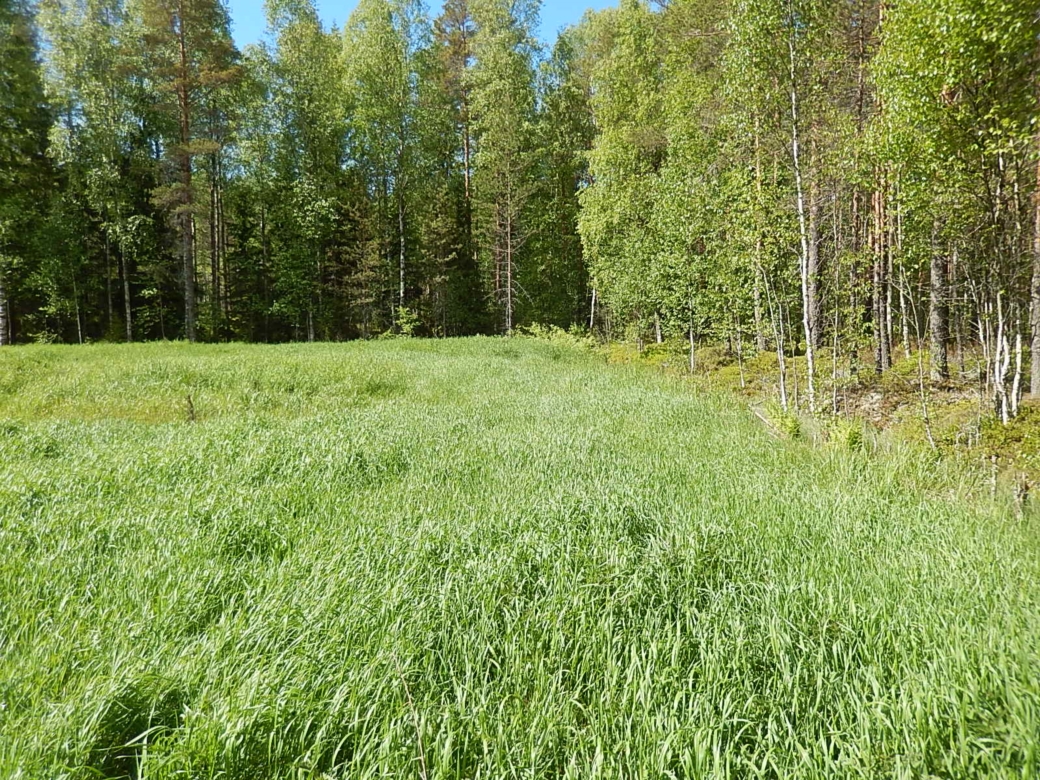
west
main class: Grassland
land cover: Grassland without tree/shrub cover
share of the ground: > 75 %
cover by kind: herbaceous plants 100 %
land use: Abandoned areas
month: June
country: FI
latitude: 61.8613
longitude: 22.1639
